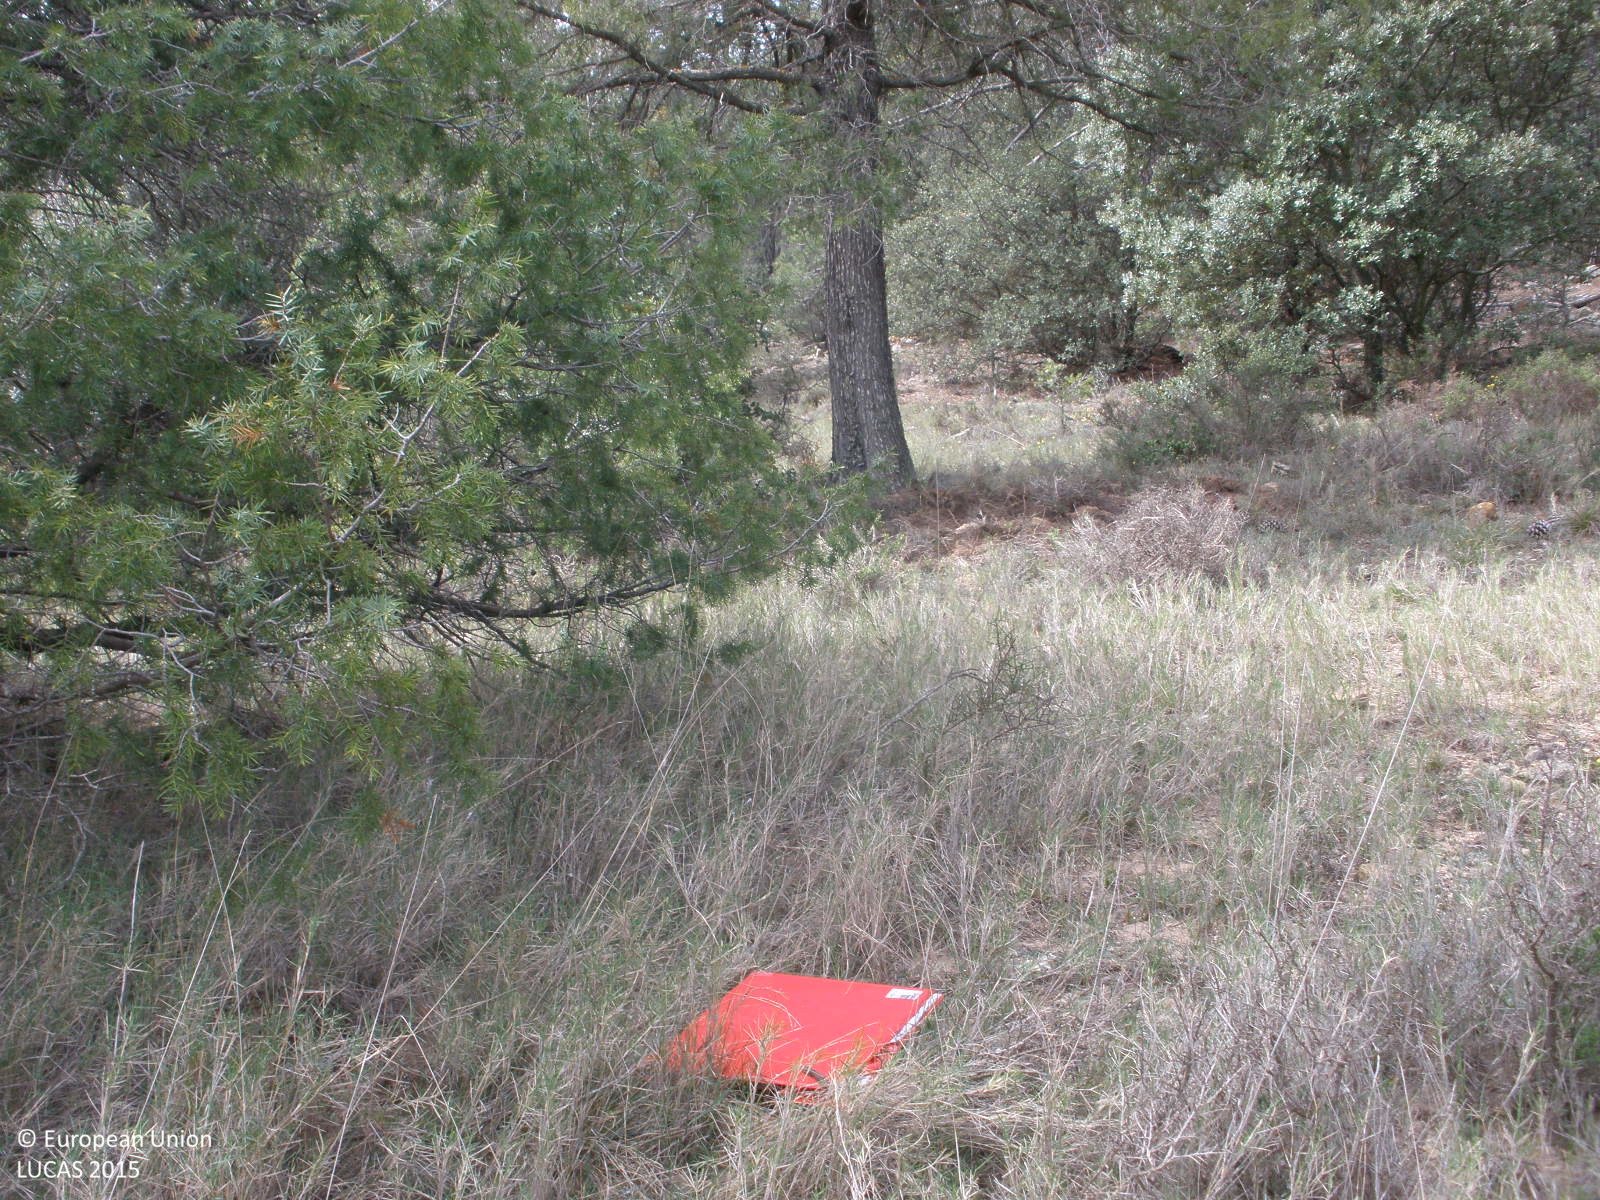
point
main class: Woodland
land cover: Other coniferous woodland
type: coniferous forest of the mediterranean region
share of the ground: 50 - 75 %
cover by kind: coniferous forest trees 50 %, shrubs 30 %, herbaceous plants 10 %, unconsolidated bare surface 10 %
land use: Forestry
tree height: < 5 m
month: April
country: ES
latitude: 40.2695
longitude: -0.8150
